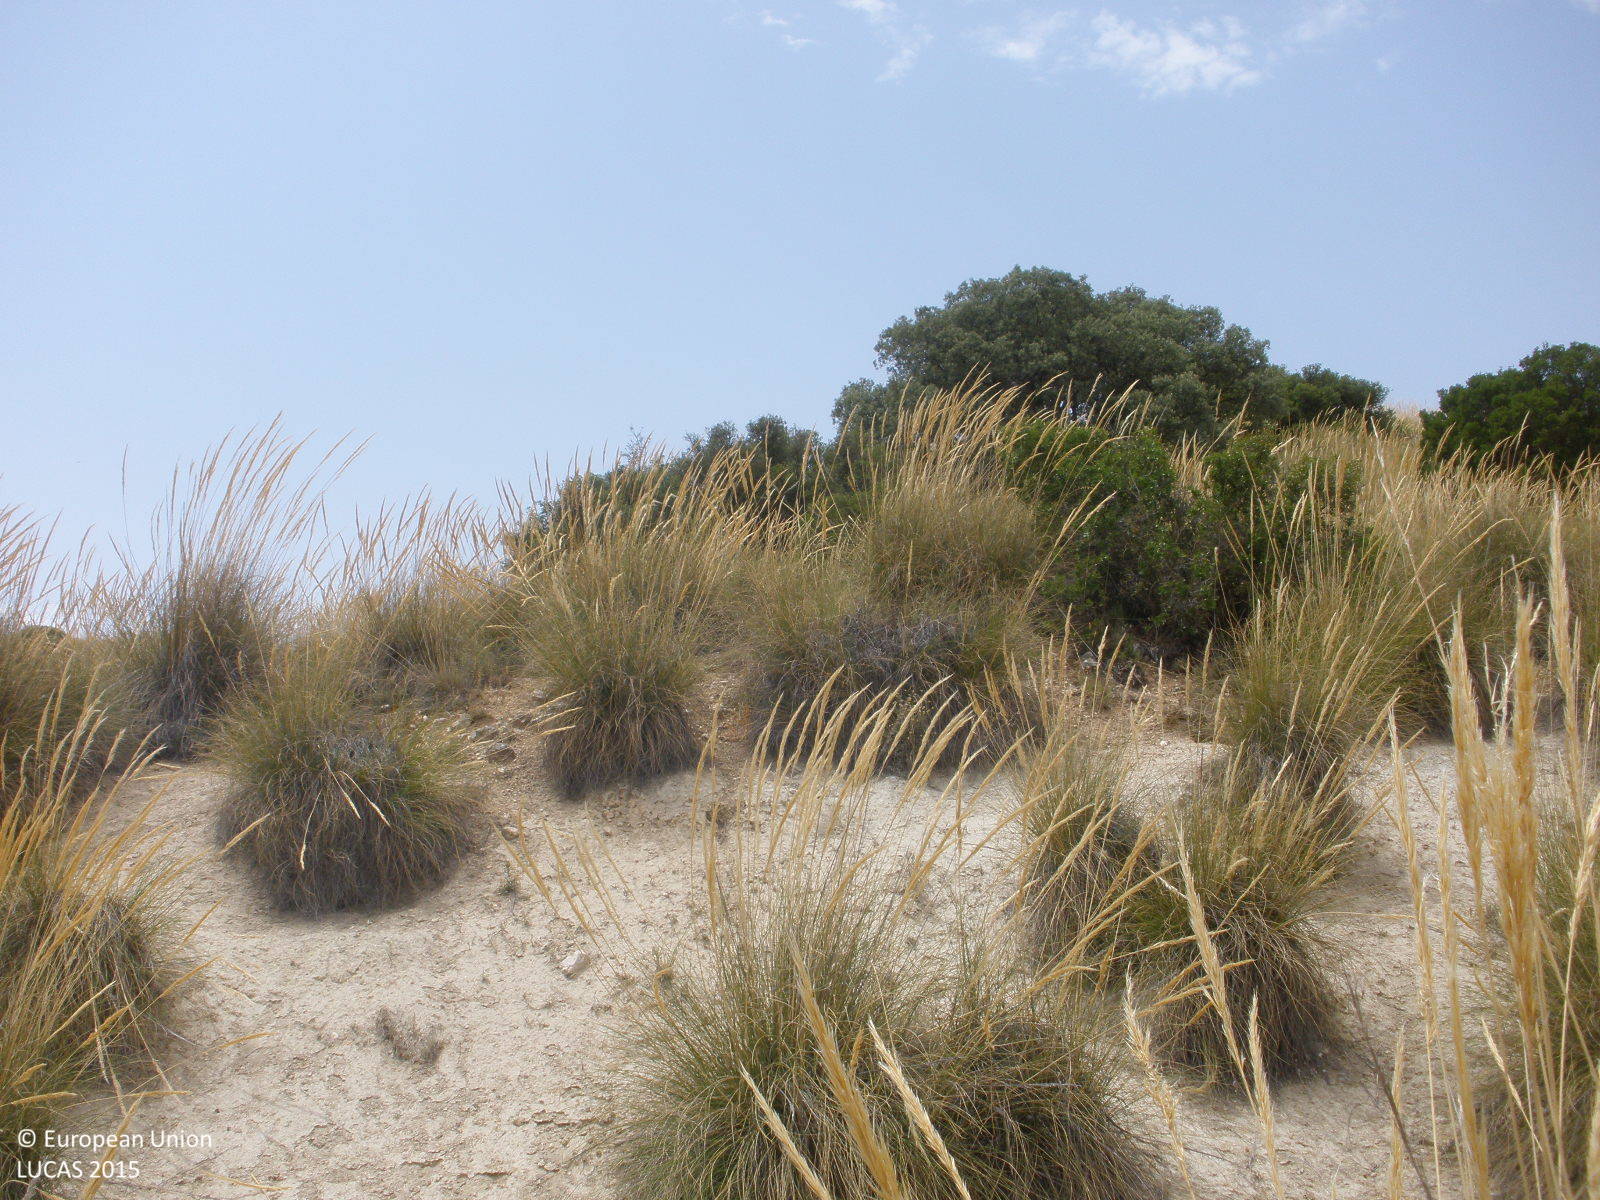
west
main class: Grassland
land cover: Grassland with sparse tree/shrub cover
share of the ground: 50 - 75 %
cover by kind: herbaceous plants 65 %, consolidated bare surface 25 %, broadleaved forest trees 5 %, shrubs 5 %
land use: Semi-natural and natural areas not in use
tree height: < 5 m
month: July
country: ES
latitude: 39.8613
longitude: -3.3639
